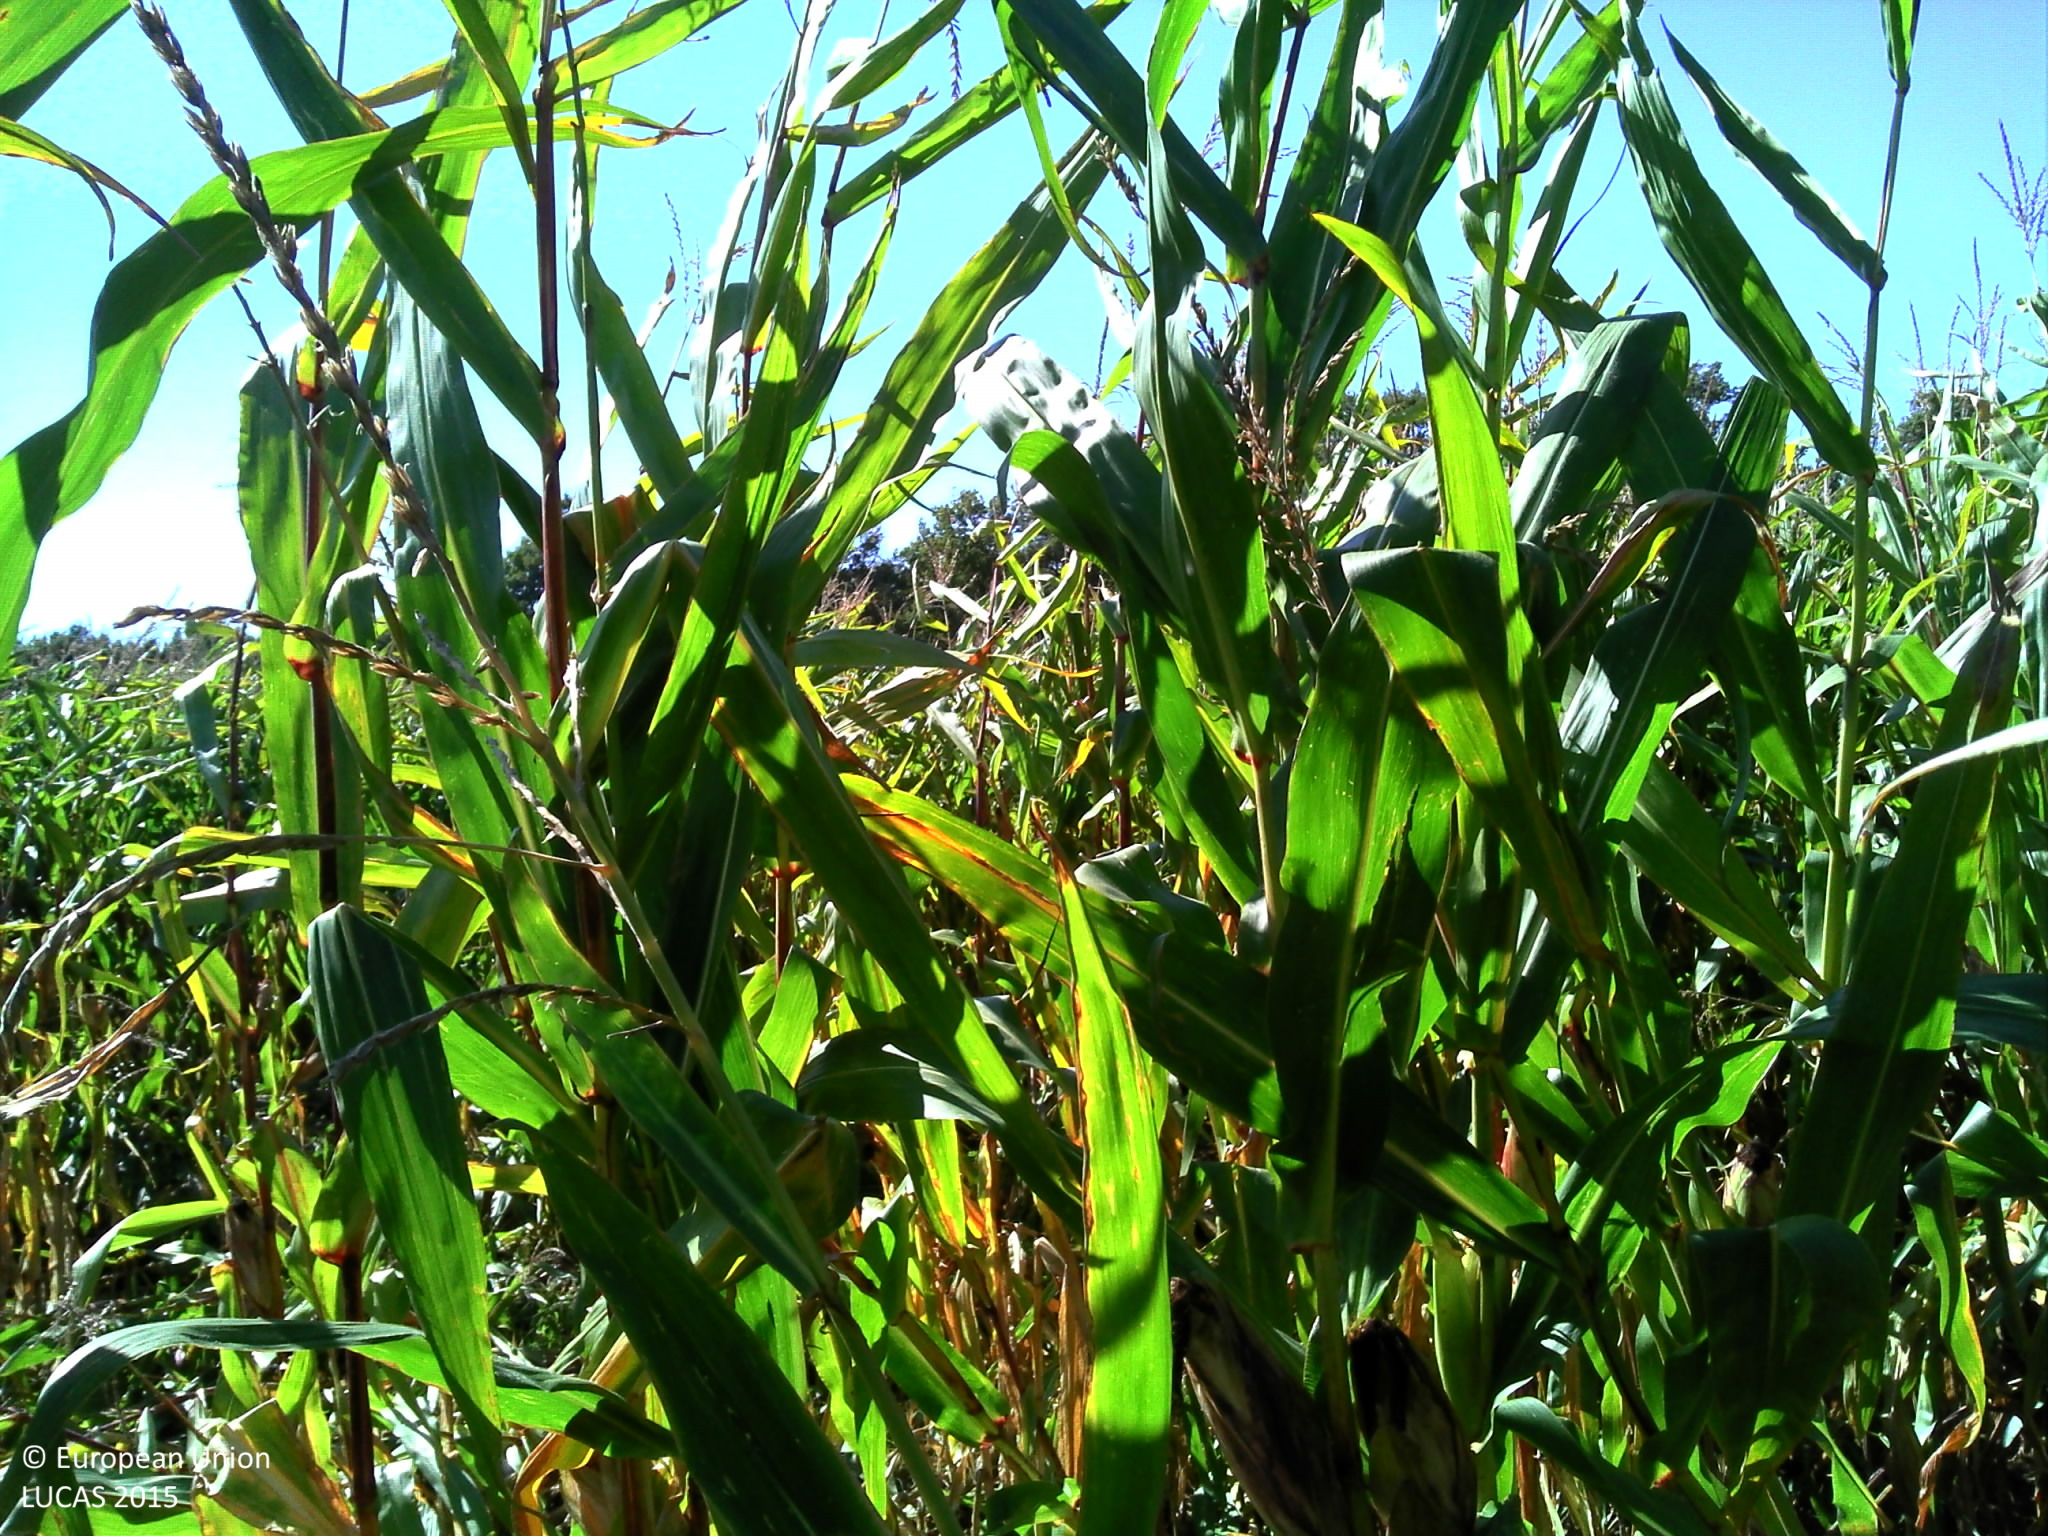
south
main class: Cropland
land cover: Maize
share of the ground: > 75 %
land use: Agriculture (excluding fallow land and kitchen gardens)
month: September
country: FR
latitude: 46.5839
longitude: -1.3246
